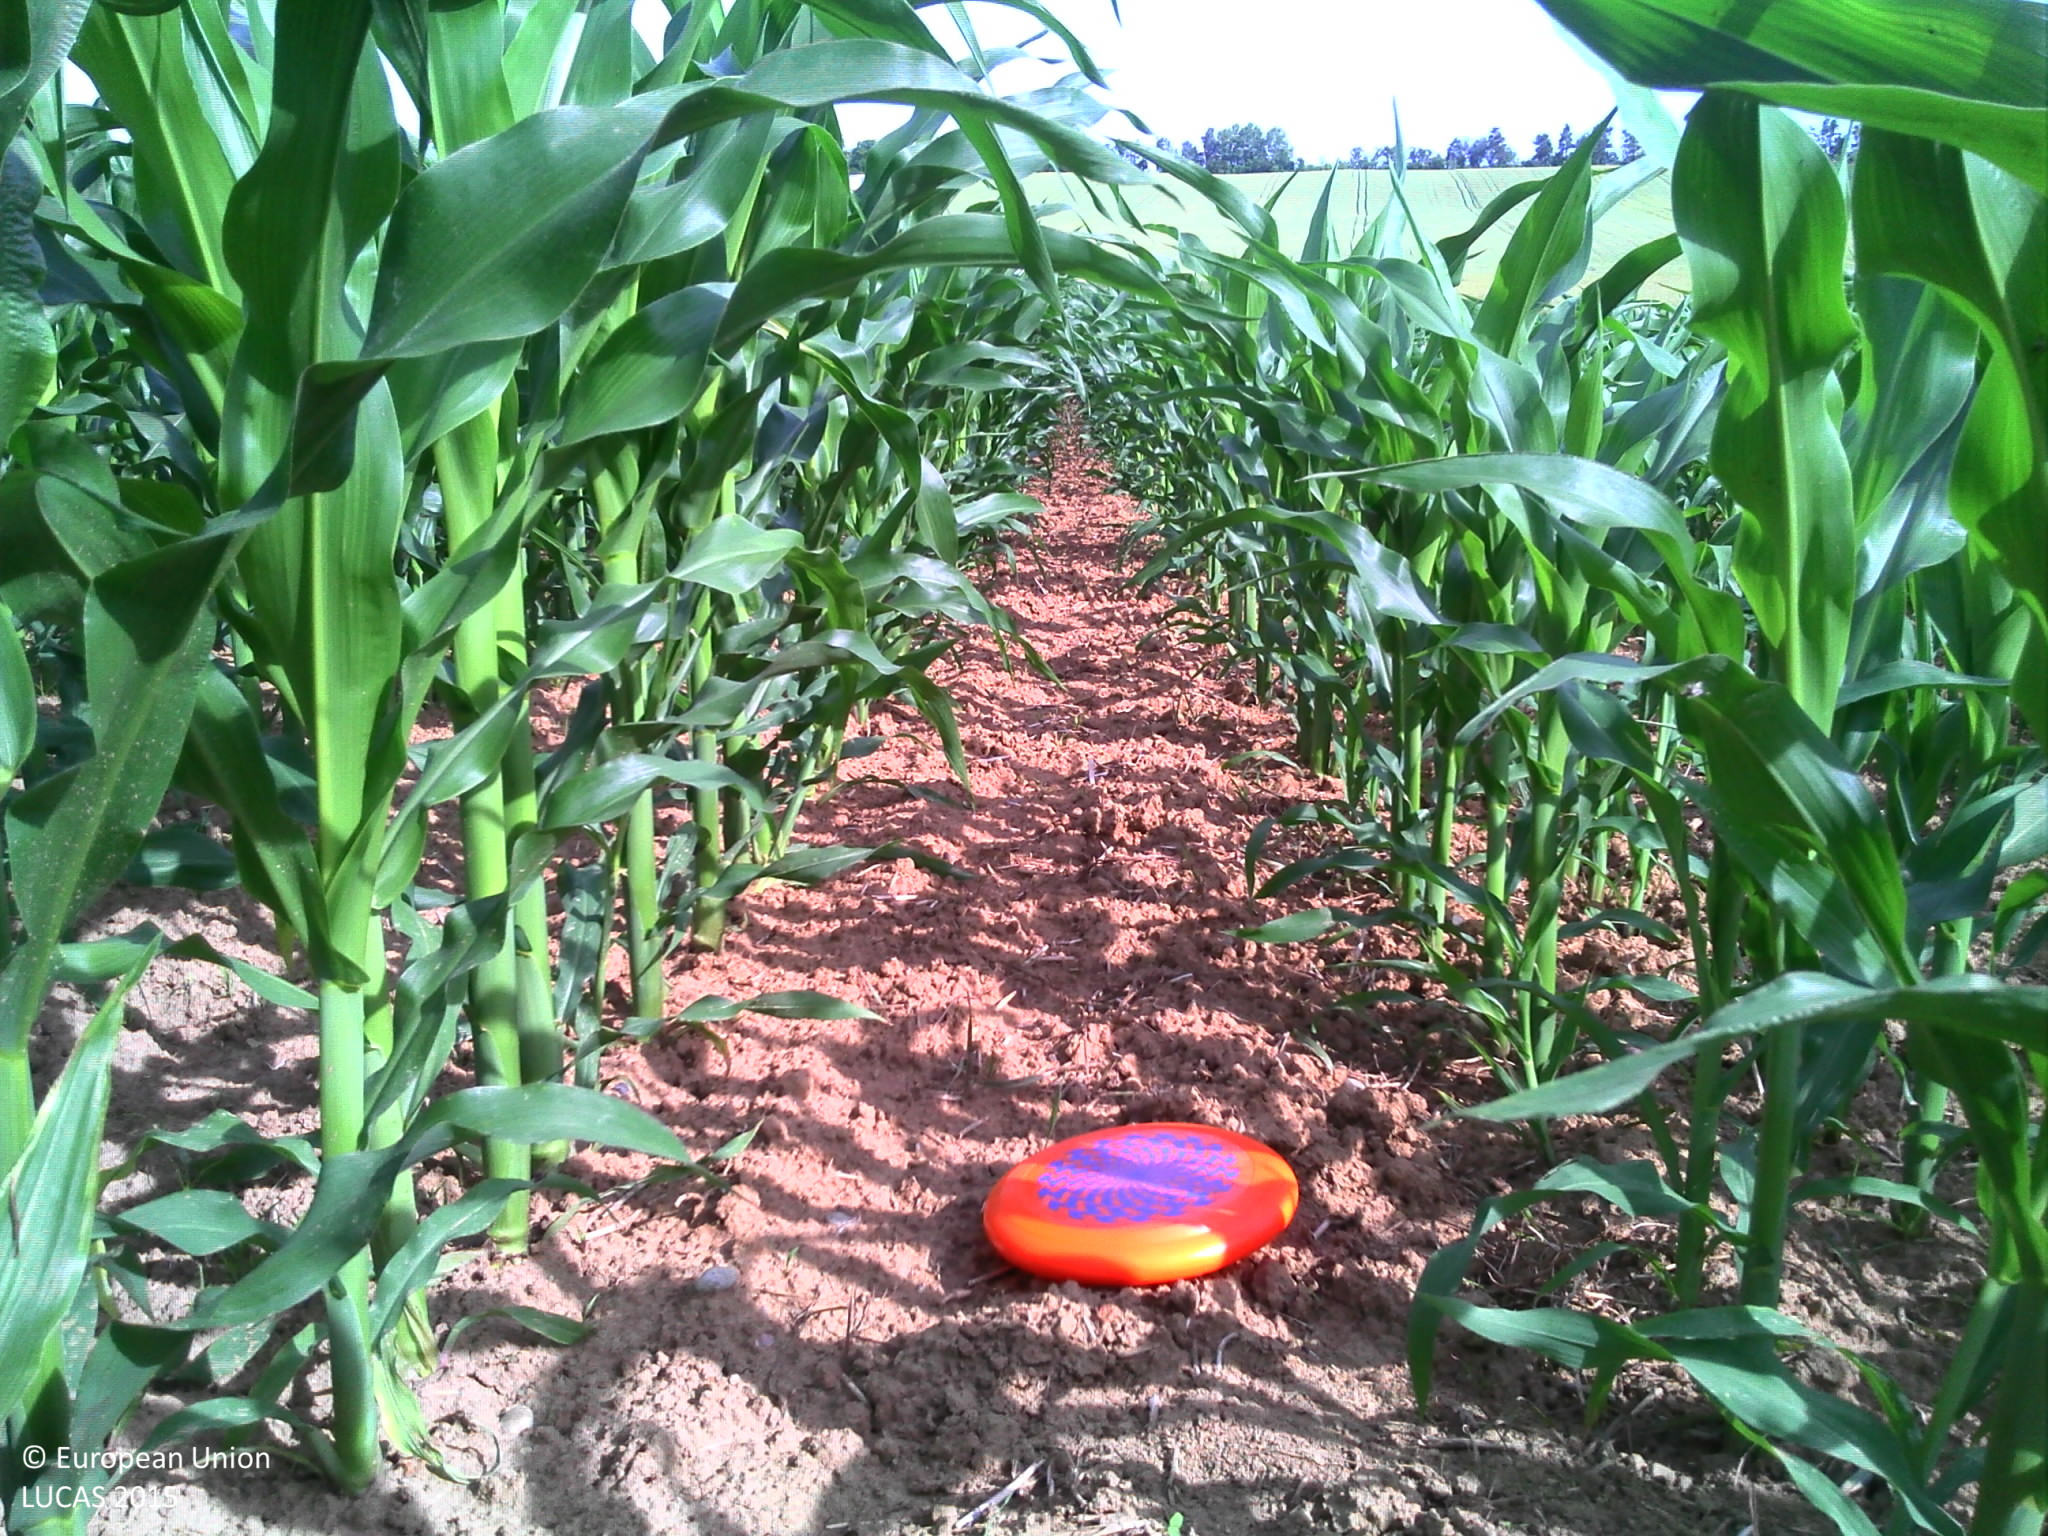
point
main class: Cropland
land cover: Maize
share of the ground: > 75 %
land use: Agriculture (excluding fallow land and kitchen gardens)
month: June
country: FR
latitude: 48.7733
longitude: 7.5923
